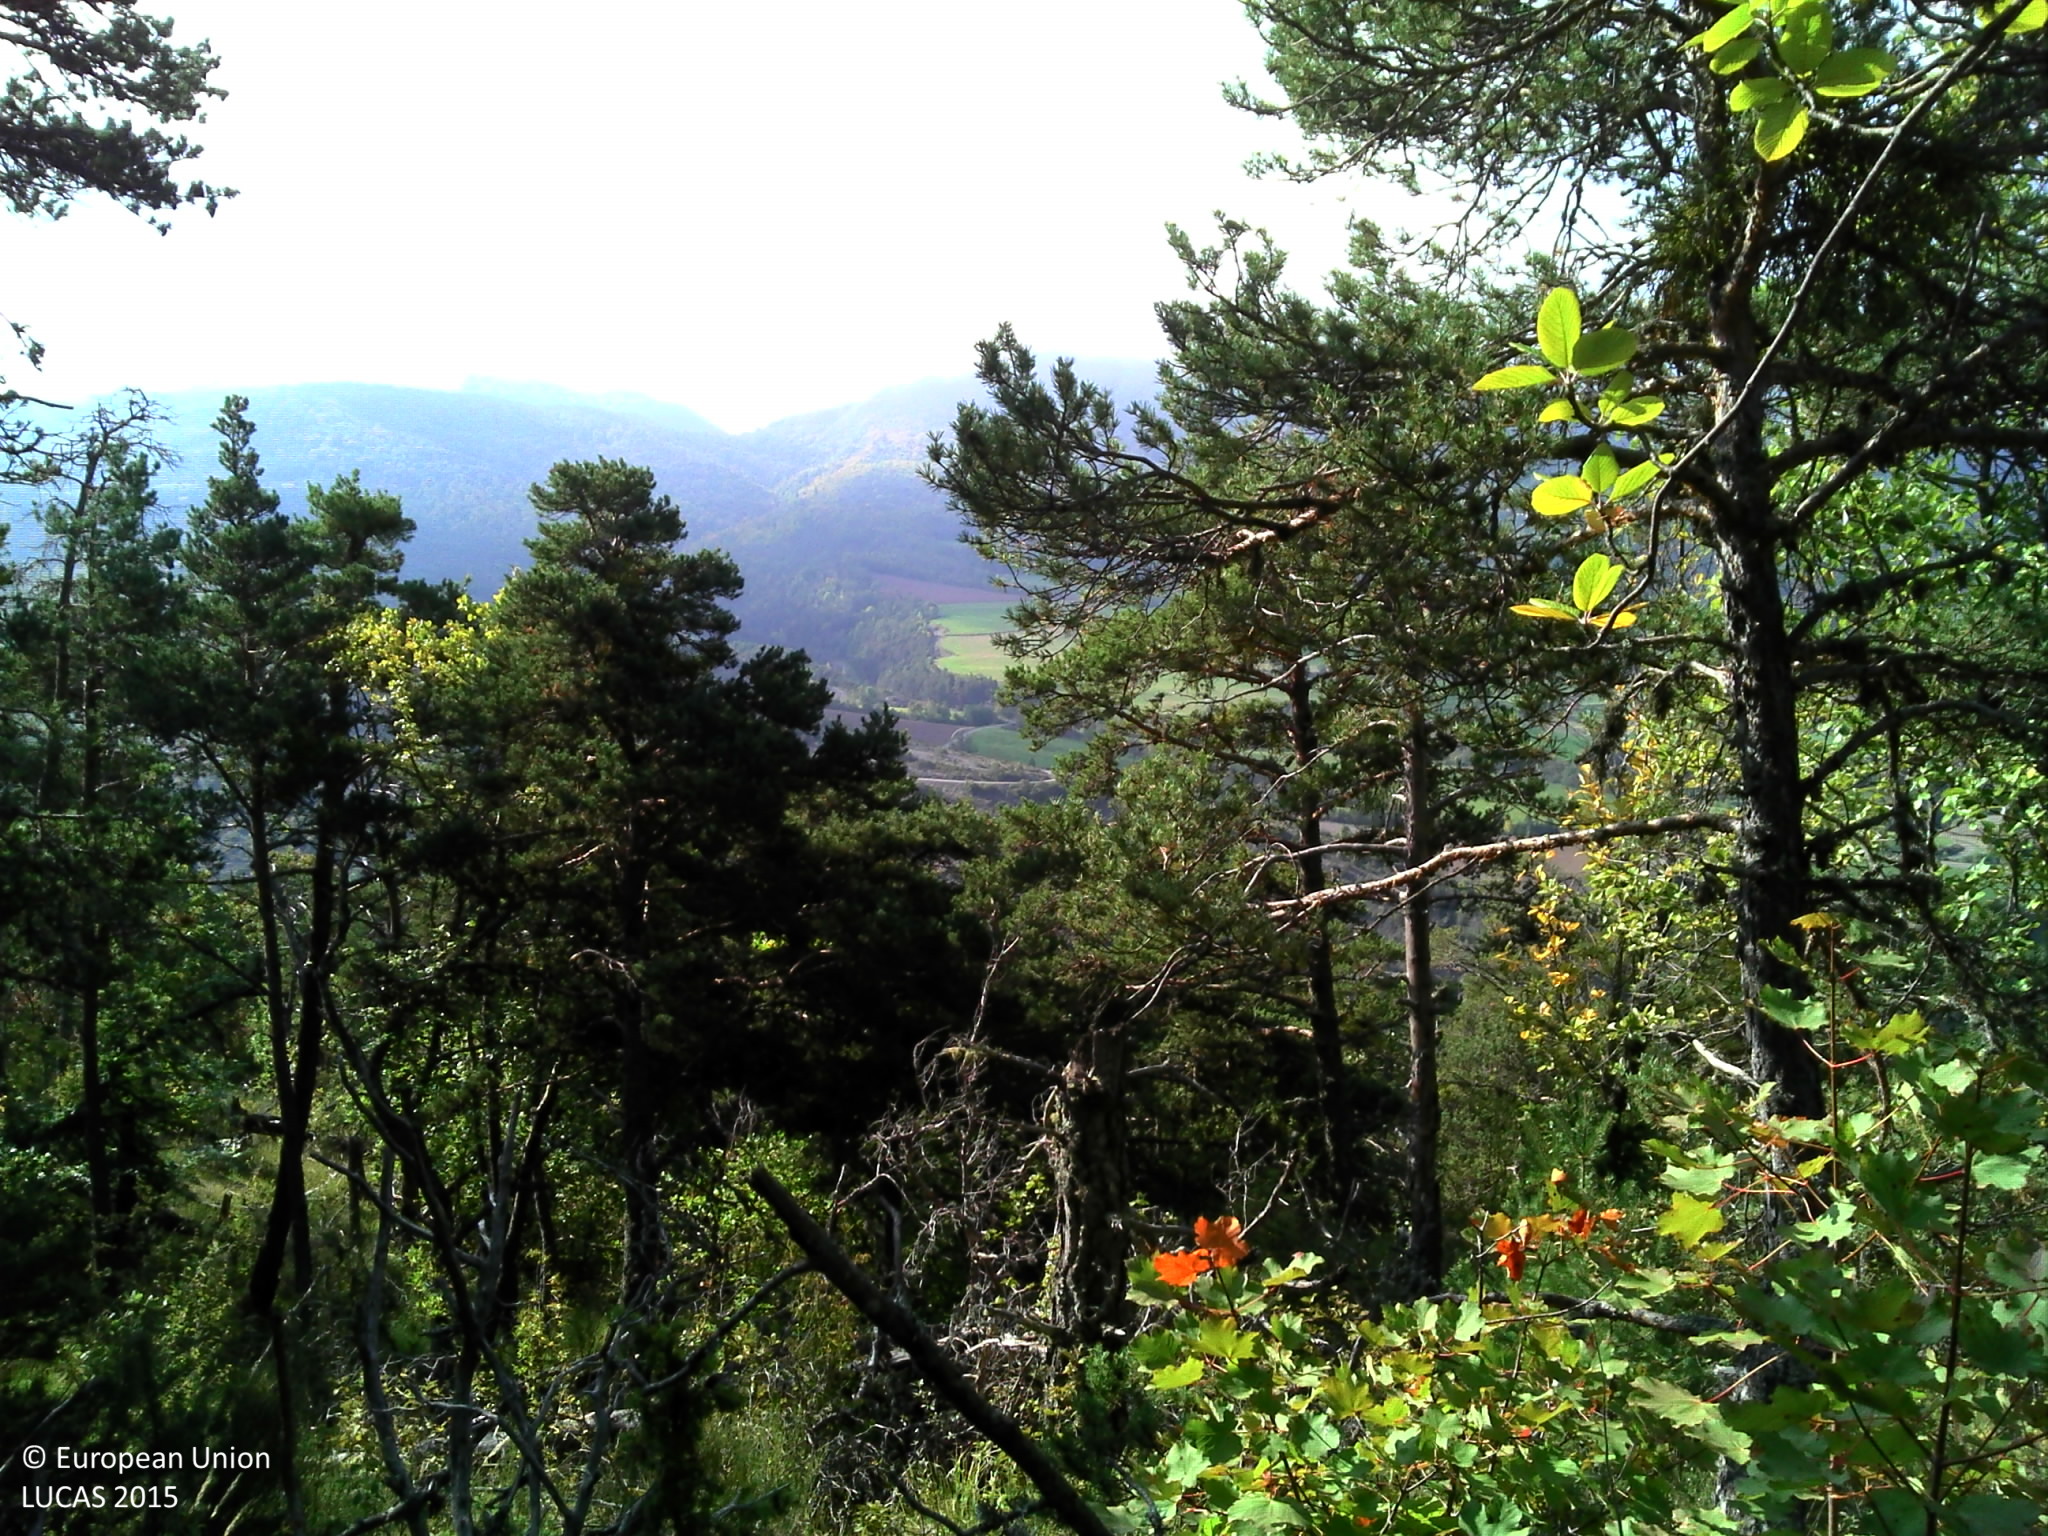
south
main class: Woodland
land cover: Pine dominated coniferous woodland
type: alpine coniferous forest
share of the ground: > 75 %
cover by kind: coniferous forest trees 50 %, herbaceous plants 20 %, broadleaved forest trees 10 %, shrubs 10 %, unconsolidated bare surface 10 %
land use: Semi-natural and natural areas not in use
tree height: > 5 m
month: September
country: FR
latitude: 44.4084
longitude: 6.2271
